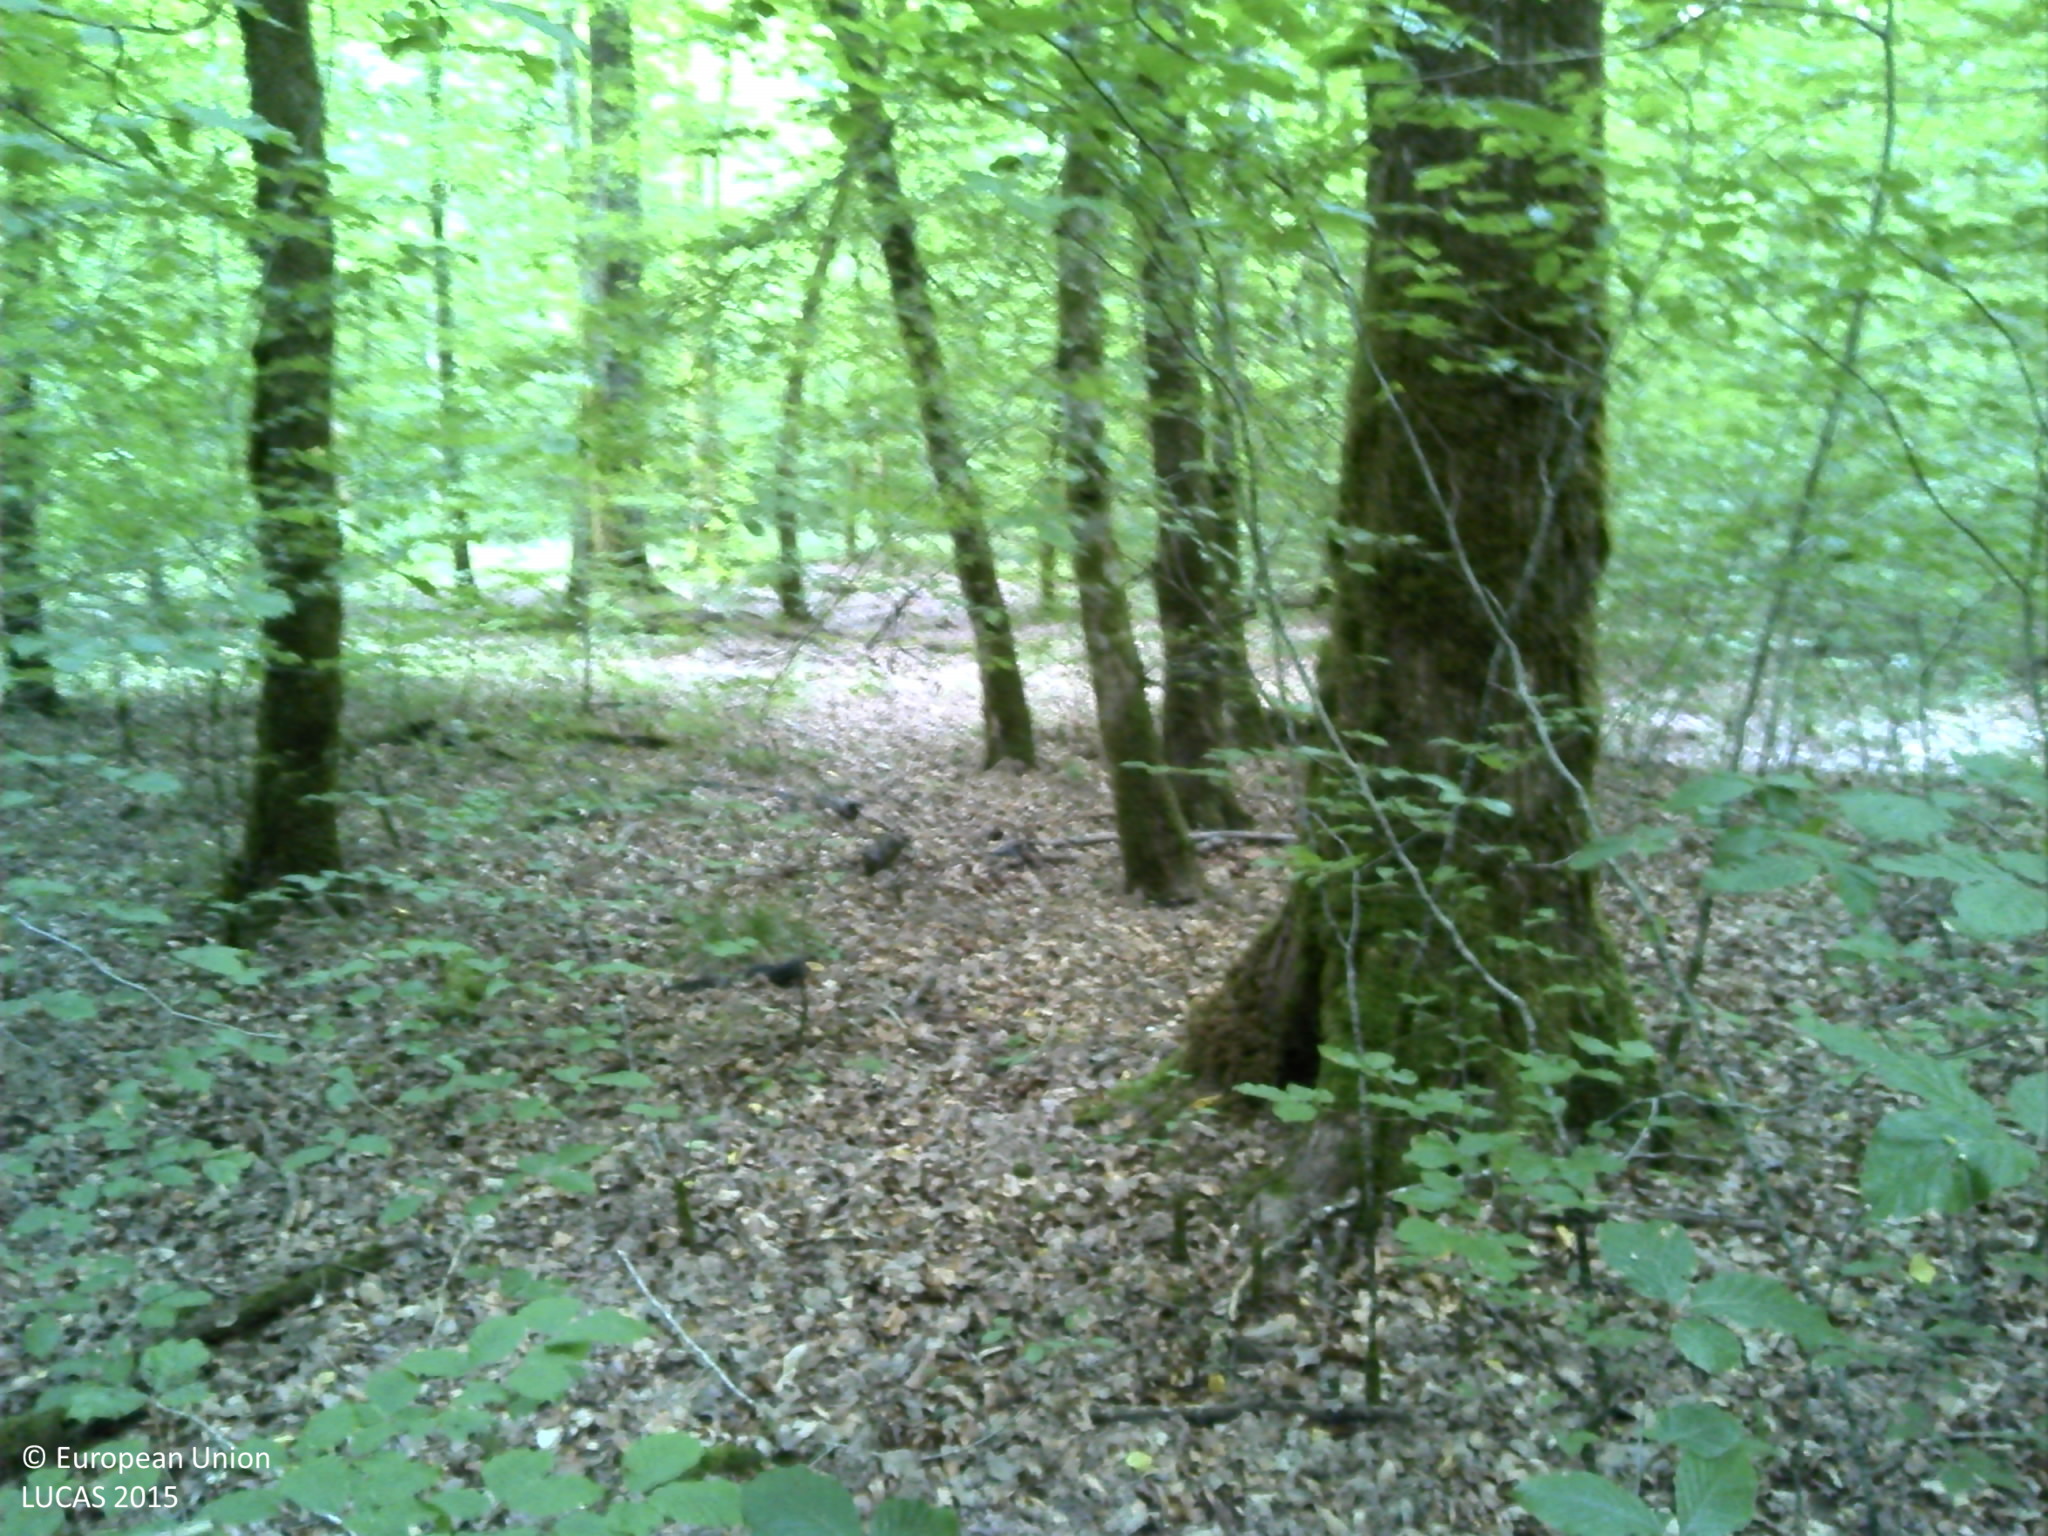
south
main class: Woodland
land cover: Broadleaved woodland
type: beech forest
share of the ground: > 75 %
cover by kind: broadleaved forest trees 100 %
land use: Forestry
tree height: > 5 m
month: July
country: FR
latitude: 48.1003
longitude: 6.0928
